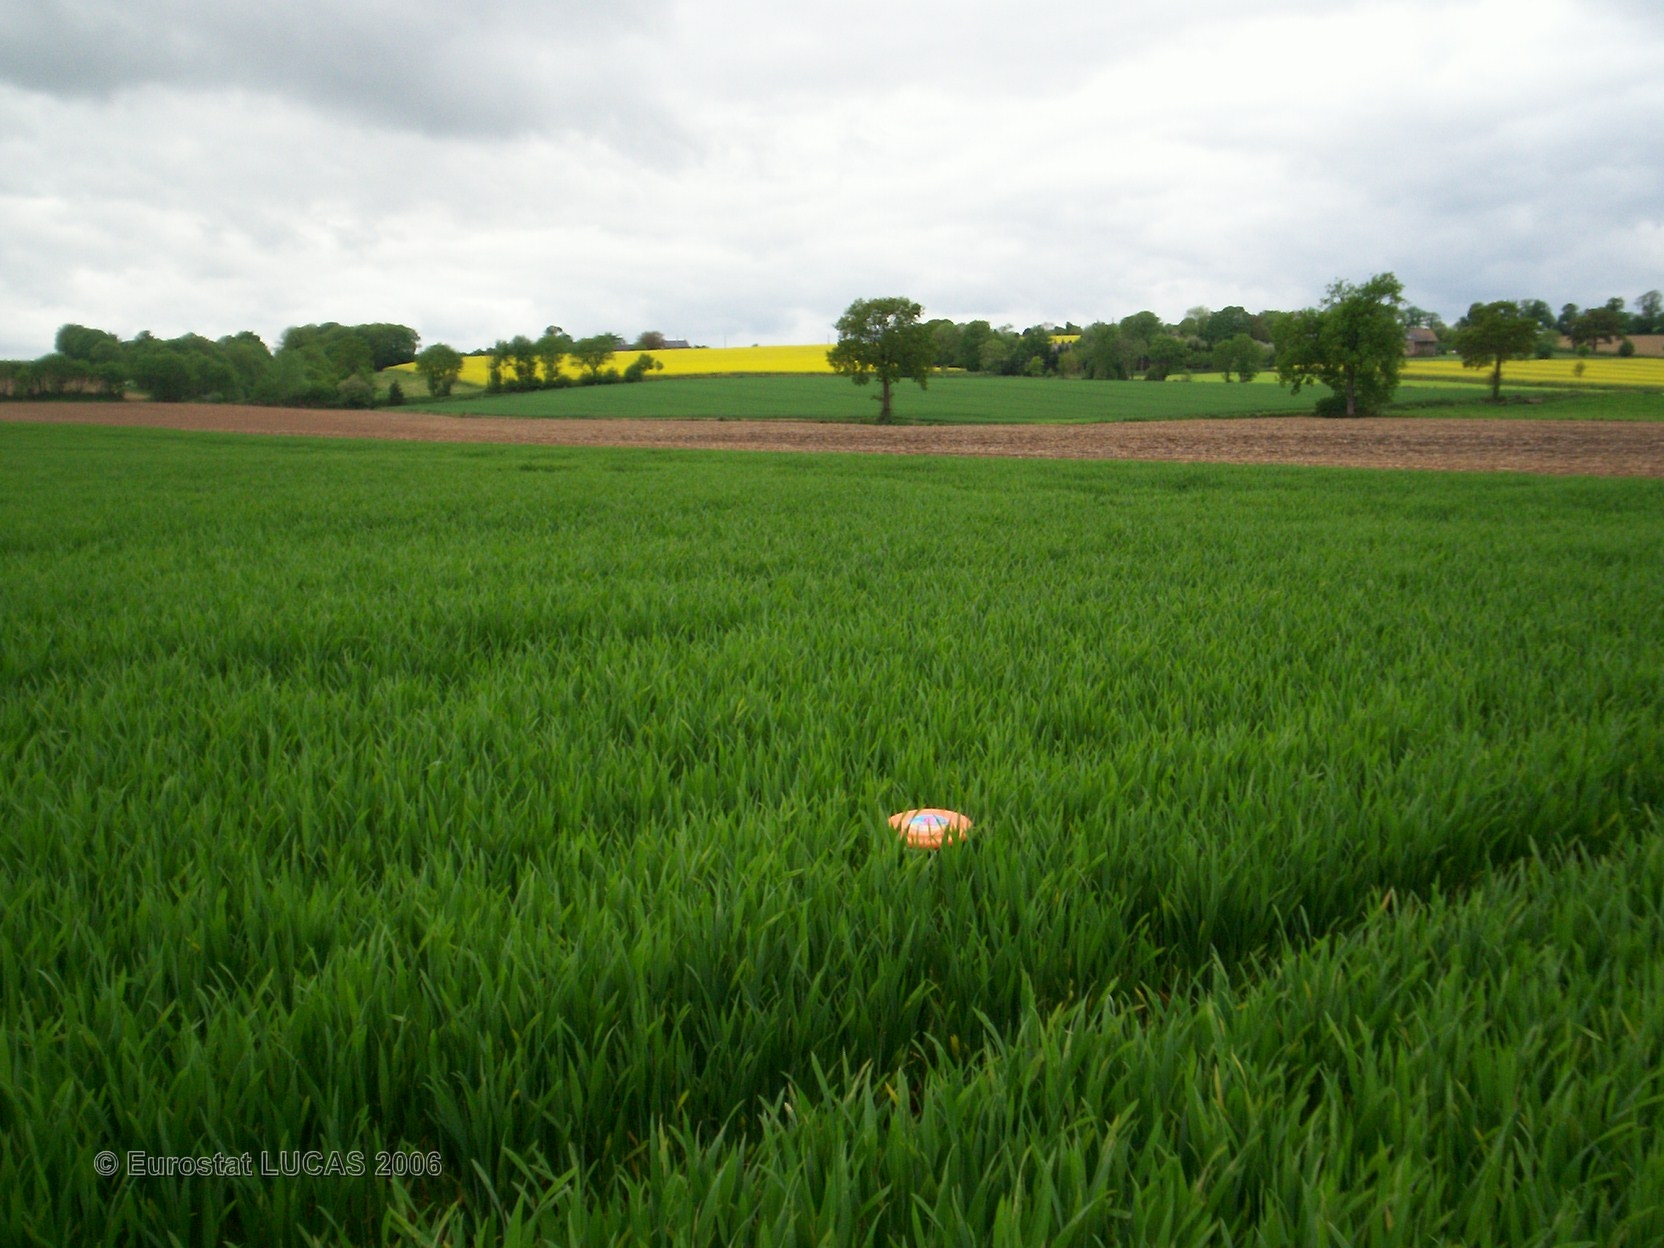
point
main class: Cropland
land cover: Common wheat
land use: Agriculture (excluding fallow land and kitchen gardens)
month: May
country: FR
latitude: 48.2878
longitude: -1.1882
